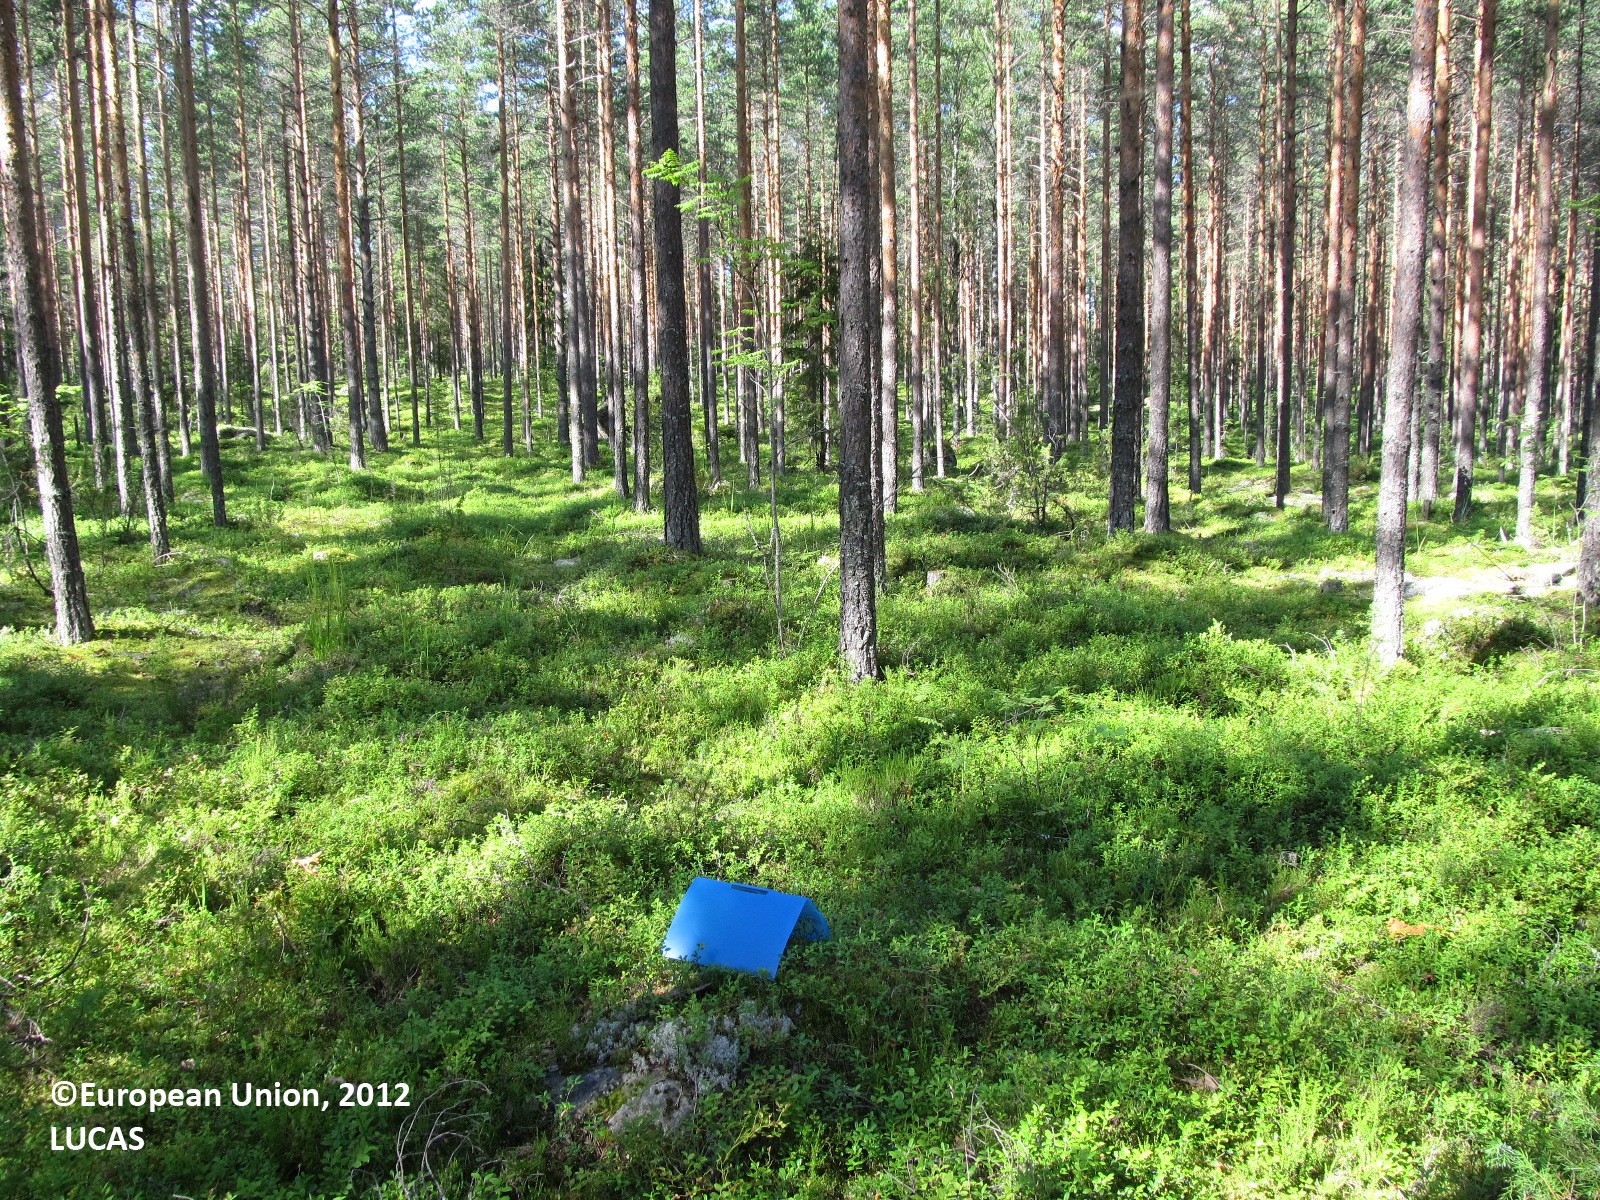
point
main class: Woodland
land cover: Pine dominated coniferous woodland
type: boreal forest
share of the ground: 50 - 75 %
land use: Forestry
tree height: > 5 m
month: July
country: FI
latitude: 61.8698
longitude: 27.9662
